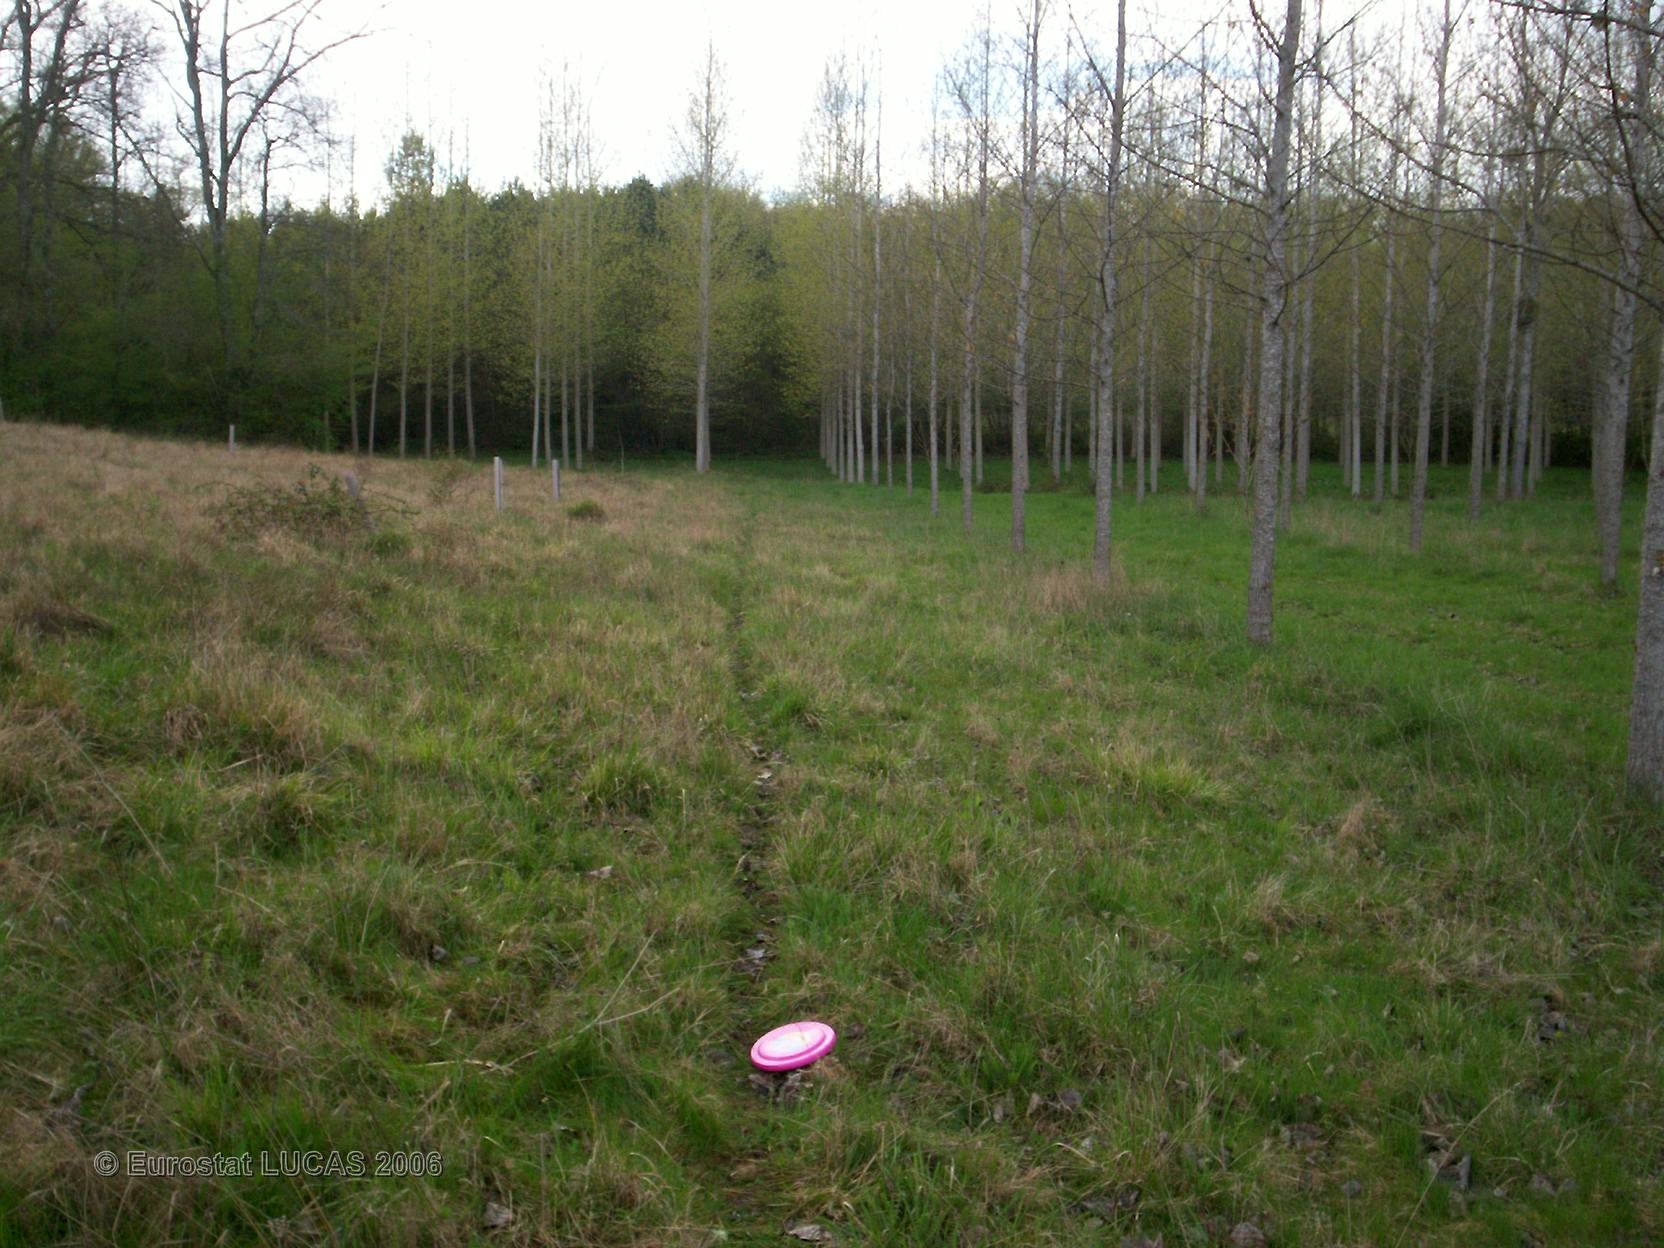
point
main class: Woodland
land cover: Broadleaved forest
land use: Forestry
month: April
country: FR
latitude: 43.9343
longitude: 0.1393
